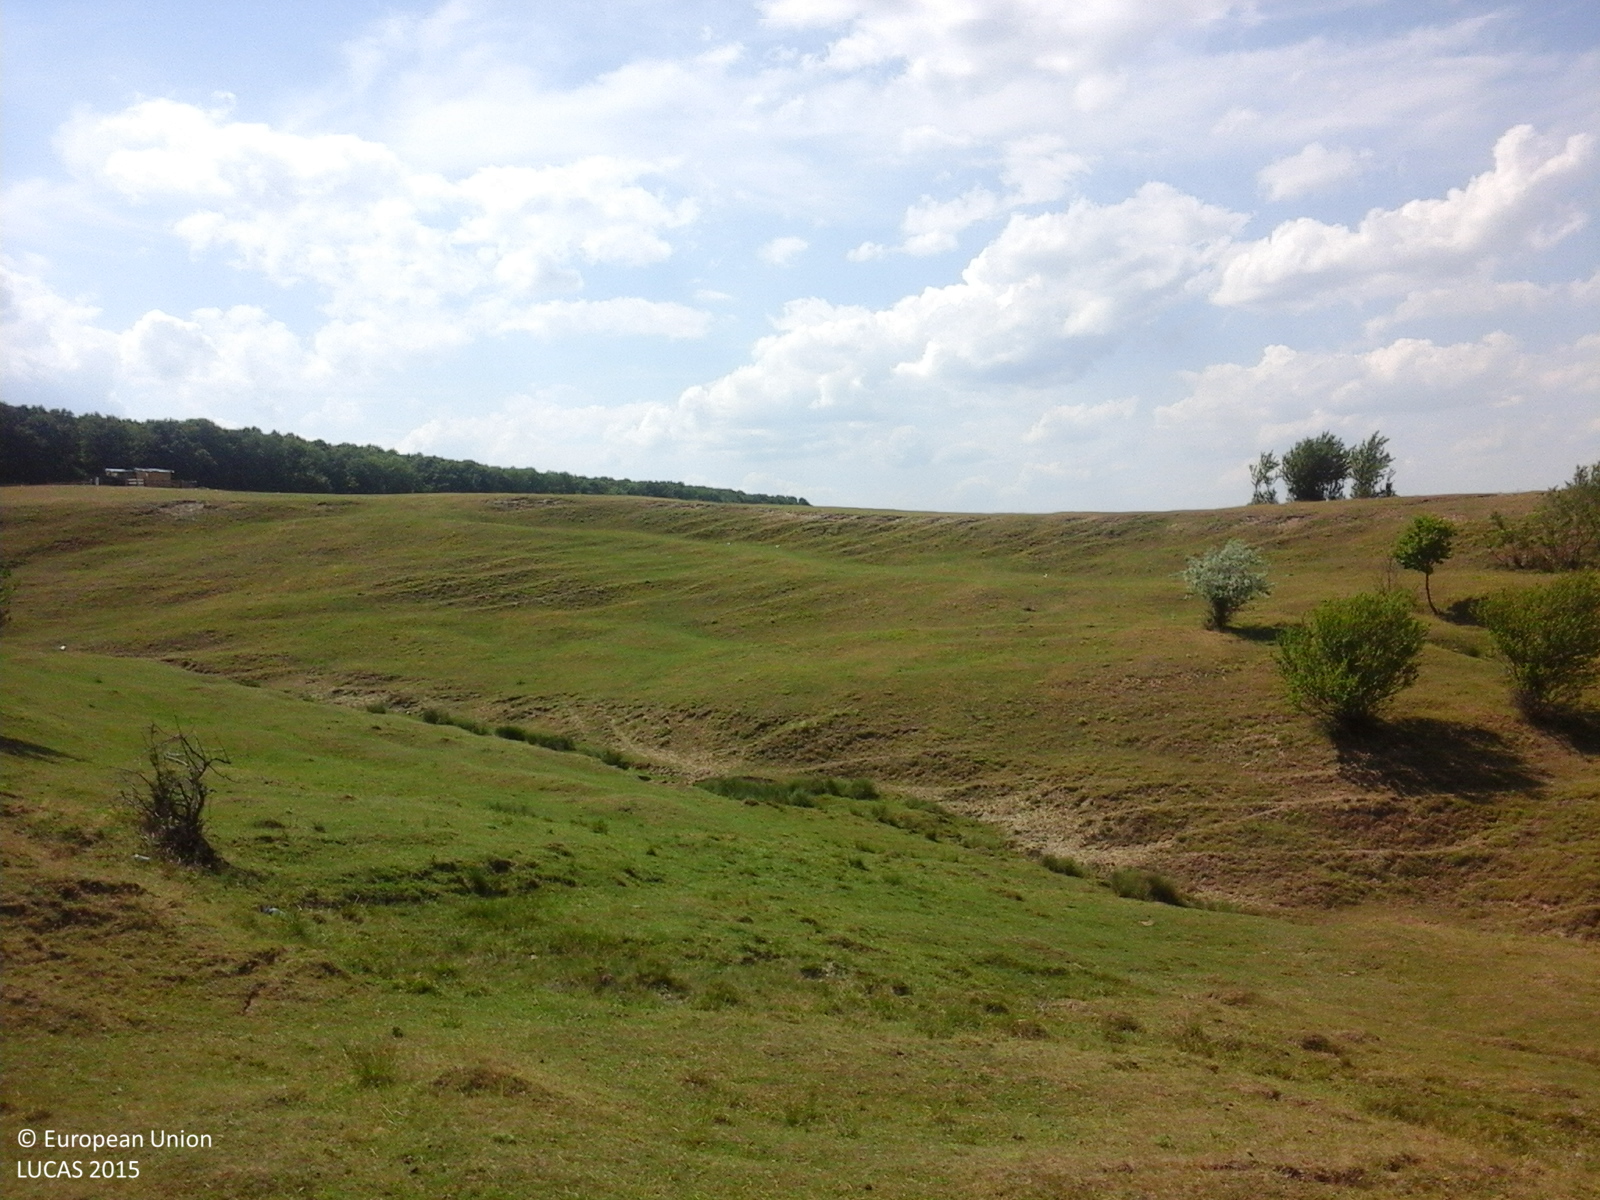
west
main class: Grassland
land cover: Grassland without tree/shrub cover
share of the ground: > 75 %
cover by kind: herbaceous plants 100 %
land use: Agriculture (excluding fallow land and kitchen gardens)
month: June
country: RO
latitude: 47.7955
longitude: 26.4980
